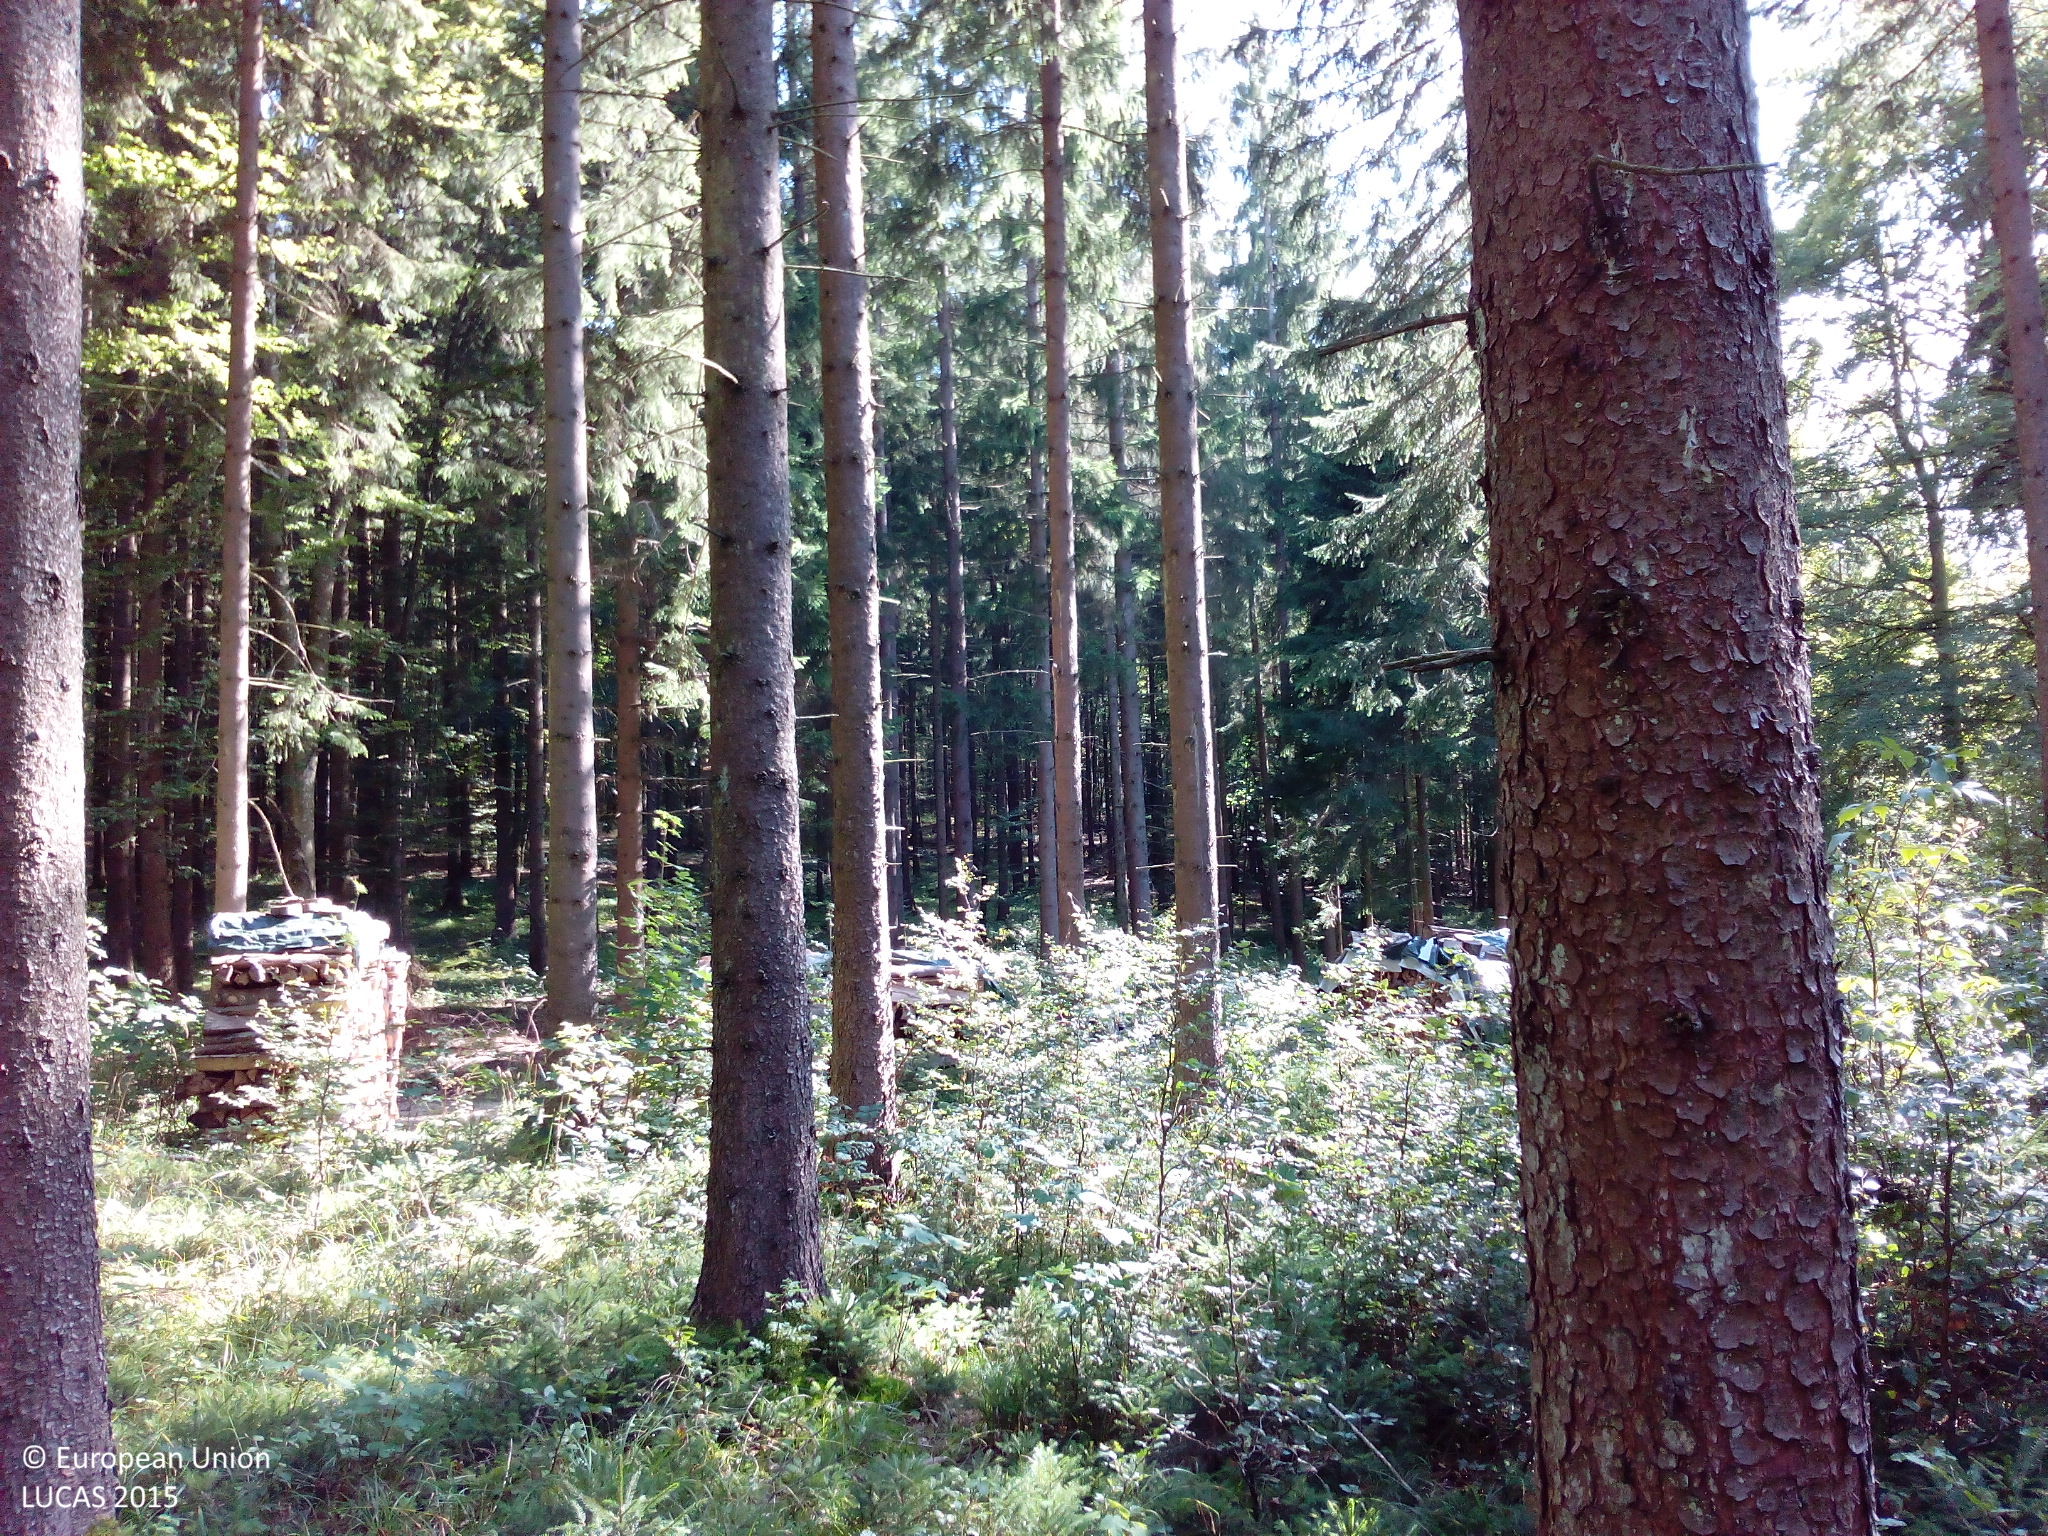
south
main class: Woodland
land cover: Spruce dominated coniferous woodland
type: hemiboreal forest and nemoral coniferous forest and mixed broadleaved-coniferous forest
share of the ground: 25 - 50 %
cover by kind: coniferous forest trees 35 %, shrubs 20 %, herbaceous plants 20 %, lichens and mosses 20 %, broadleaved forest trees 5 %
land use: Forestry
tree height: > 5 m
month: September
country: DE
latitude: 47.9819
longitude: 8.7013
